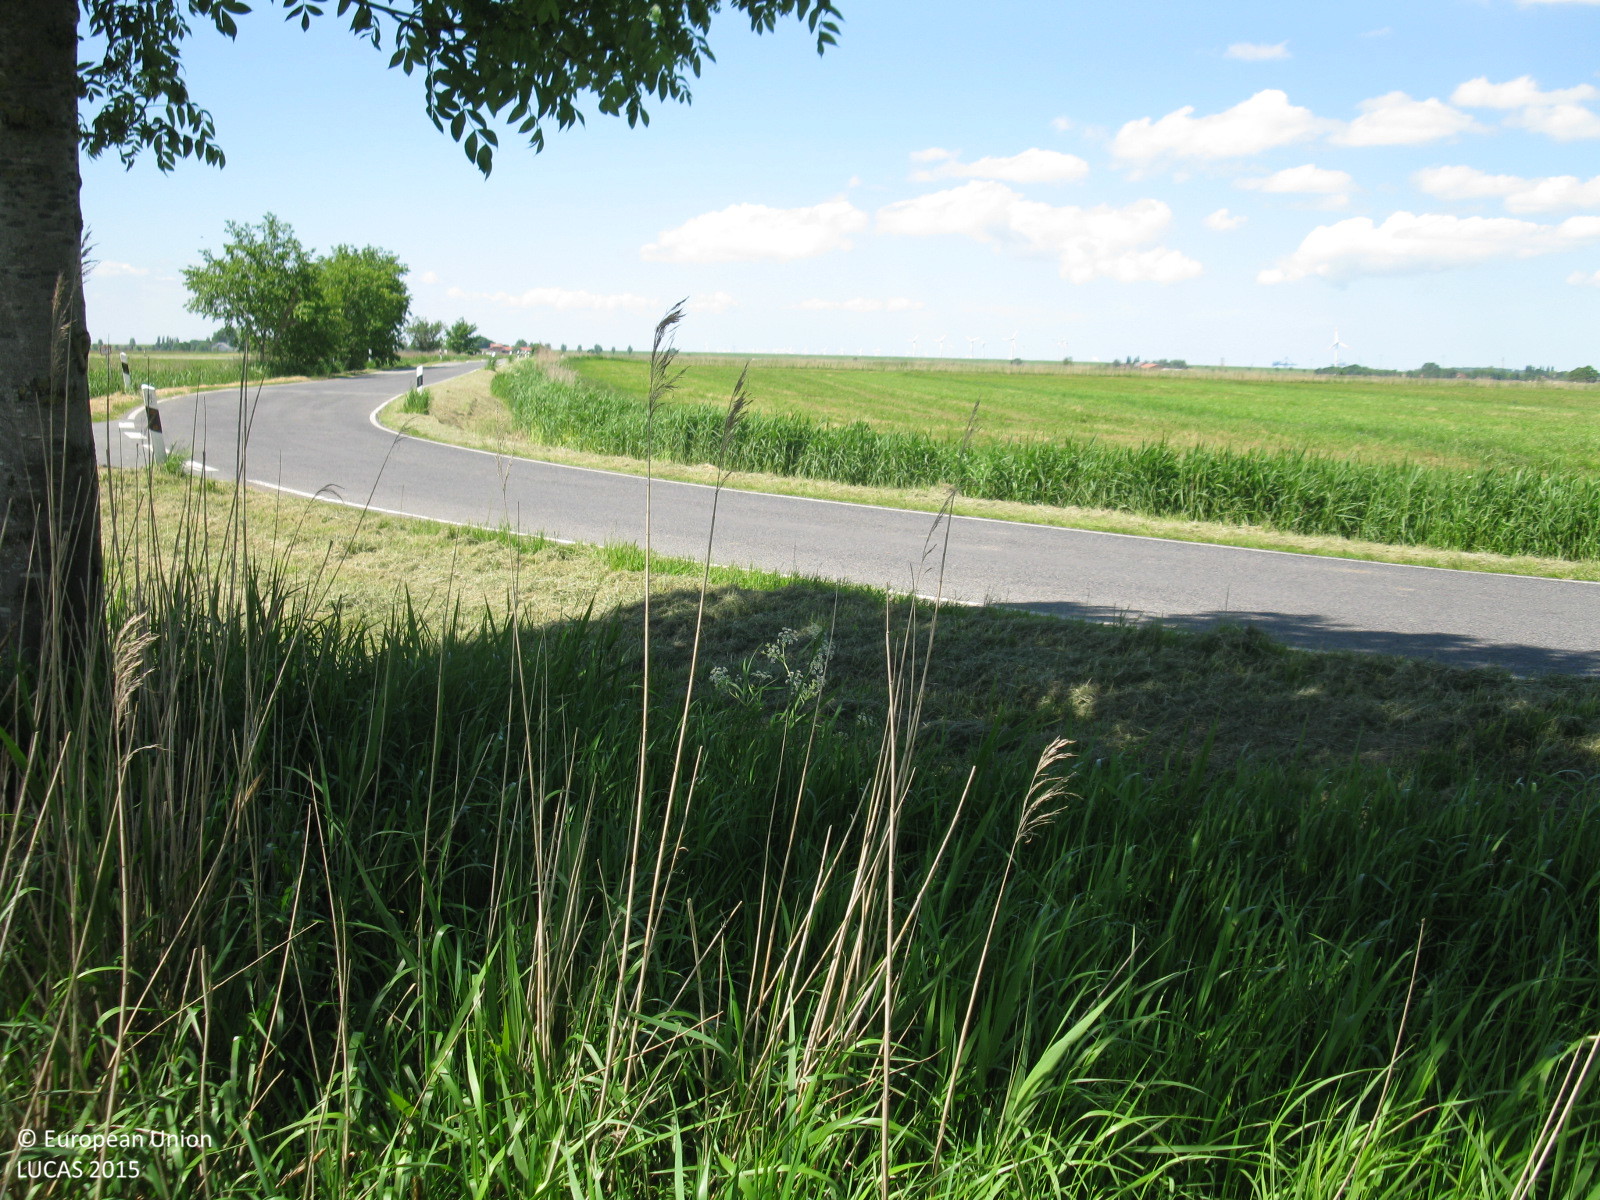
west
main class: Grassland
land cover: Grassland without tree/shrub cover
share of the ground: > 75 %
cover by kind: herbaceous plants 100 %
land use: Agriculture (excluding fallow land and kitchen gardens)
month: June
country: DE
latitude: 53.2996
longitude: 7.2847
